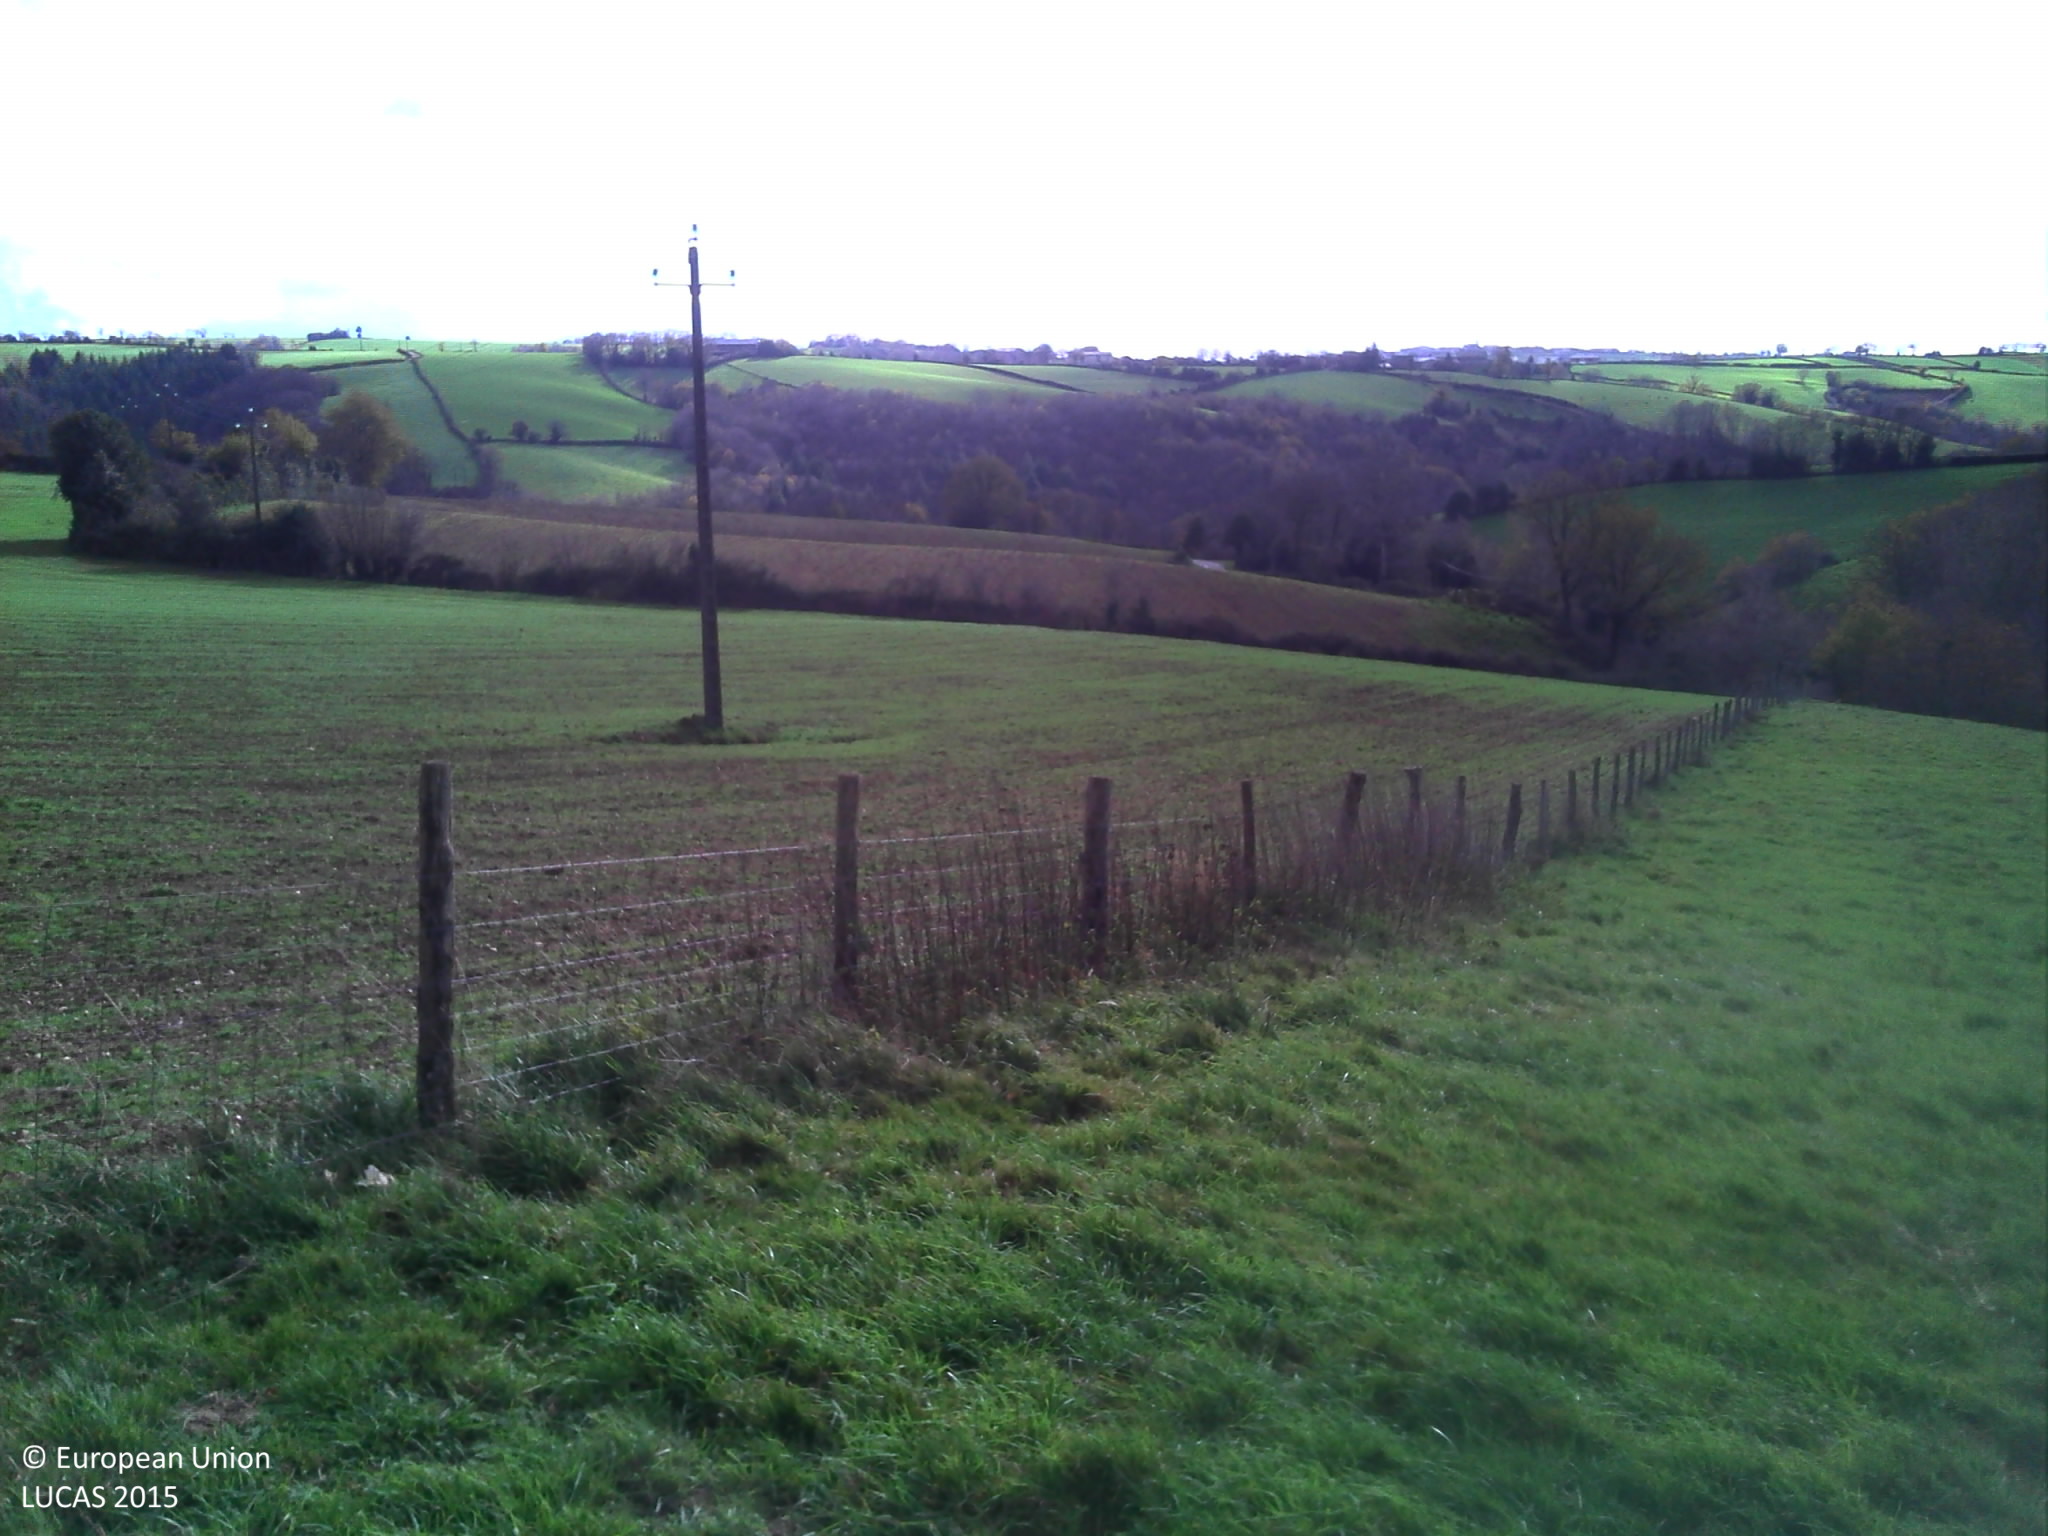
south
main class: Grassland
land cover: Grassland without tree/shrub cover
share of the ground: > 75 %
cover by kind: herbaceous plants 100 %
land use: Agriculture (excluding fallow land and kitchen gardens)
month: November
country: FR
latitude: 44.0681
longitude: 2.6010
